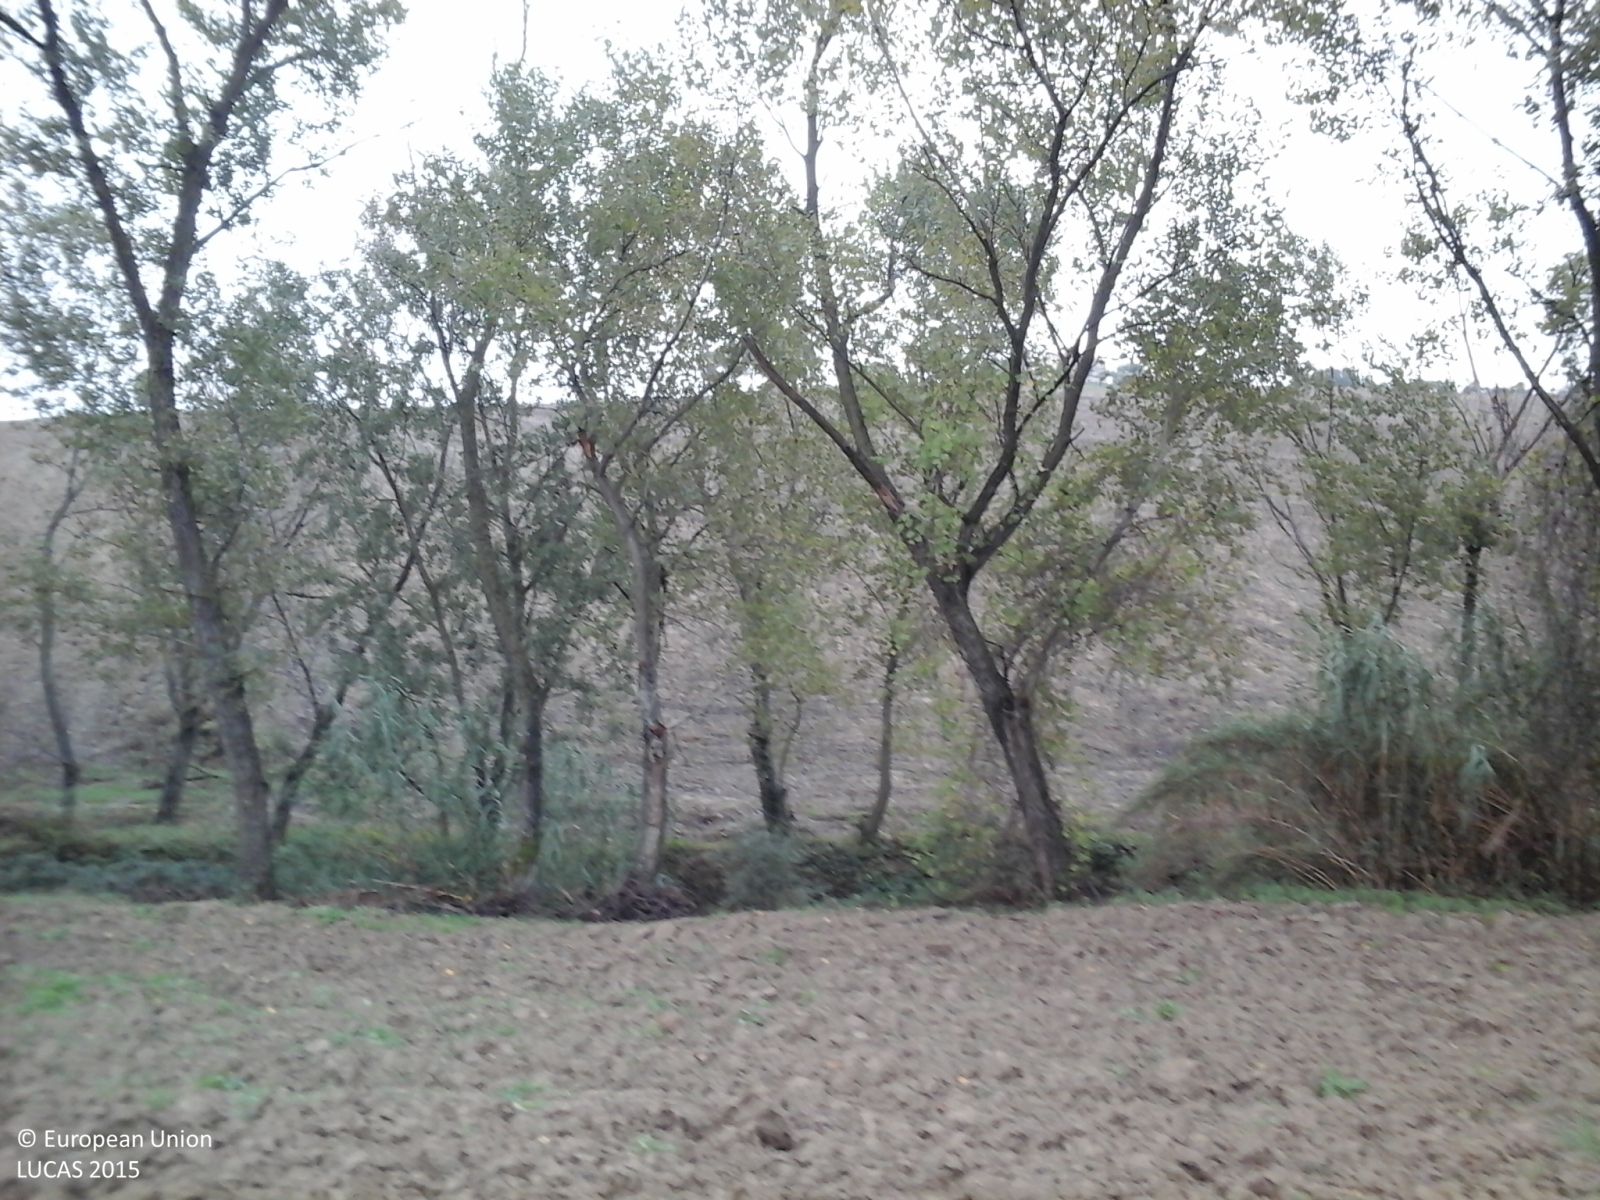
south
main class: Cropland
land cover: Durum wheat
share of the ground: < 10 %
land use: Agriculture (excluding fallow land and kitchen gardens)
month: October
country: IT
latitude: 43.6316
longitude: 13.2519
